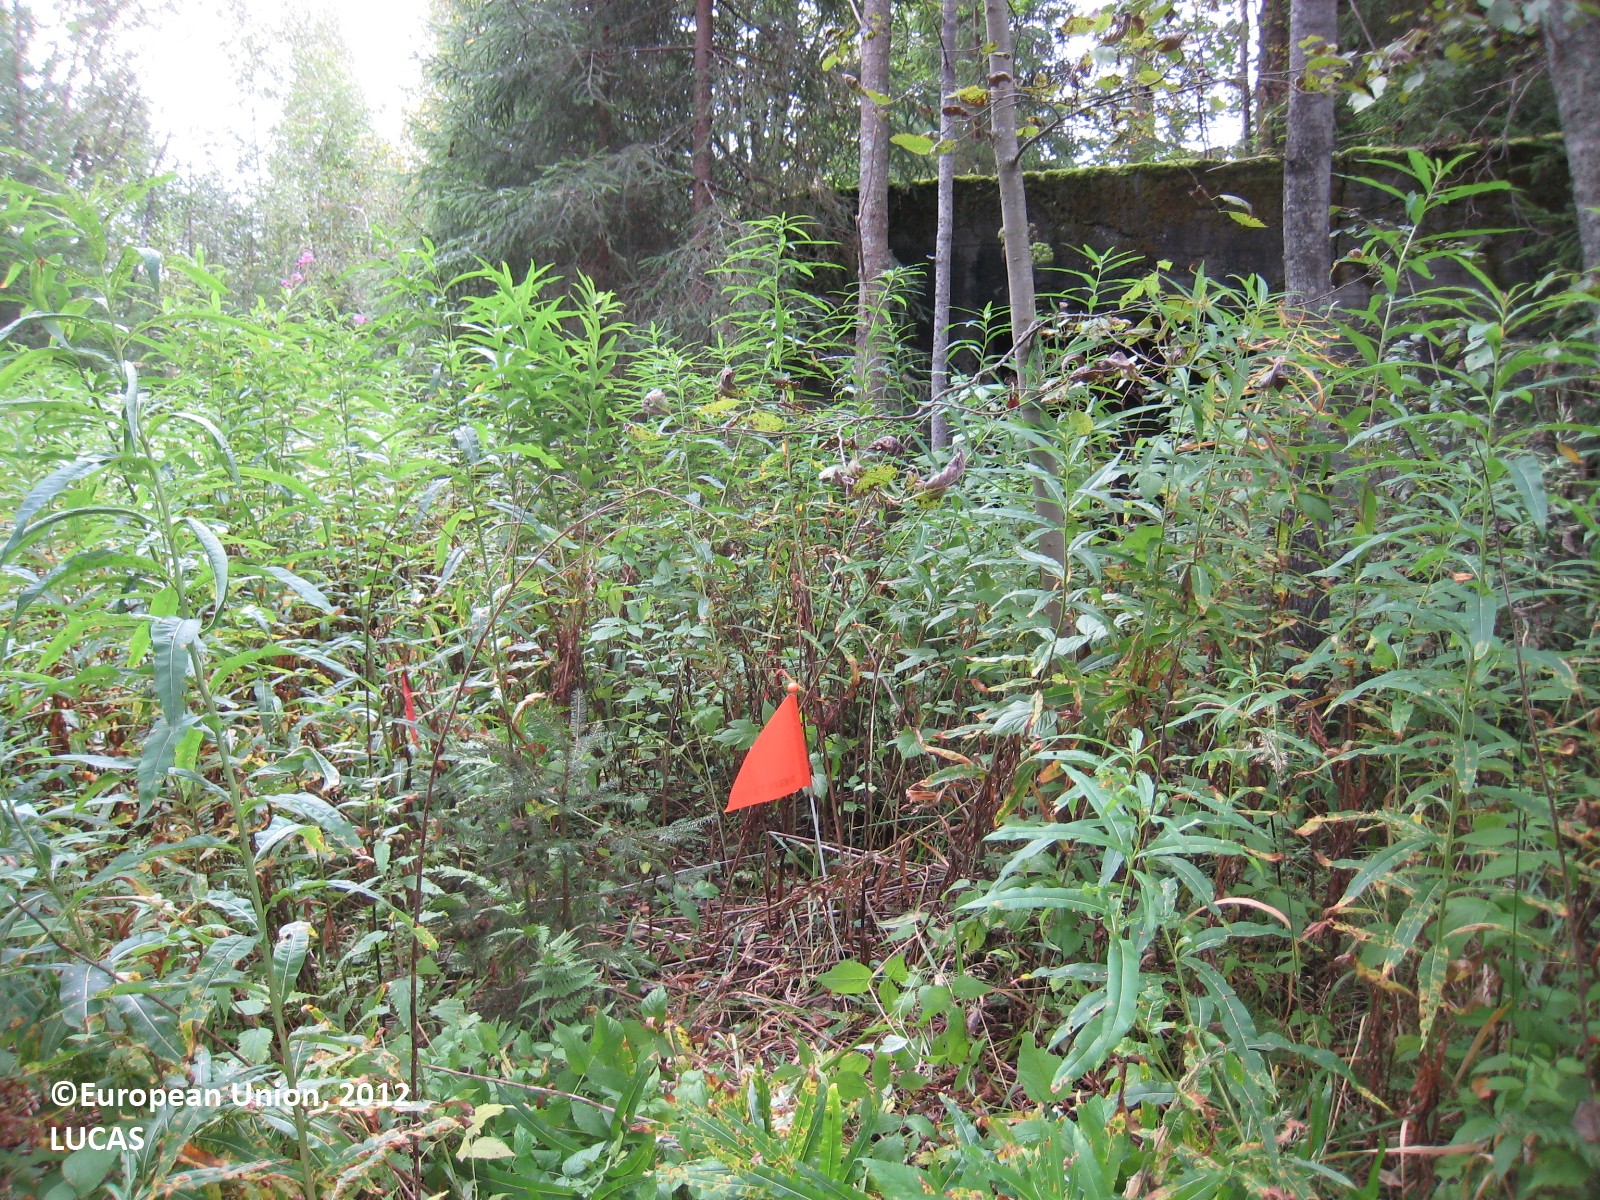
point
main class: Woodland
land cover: Spruce dominated mixed woodland
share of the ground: 50 - 75 %
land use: Forestry
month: August
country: FI
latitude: 62.3675
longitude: 27.3853
